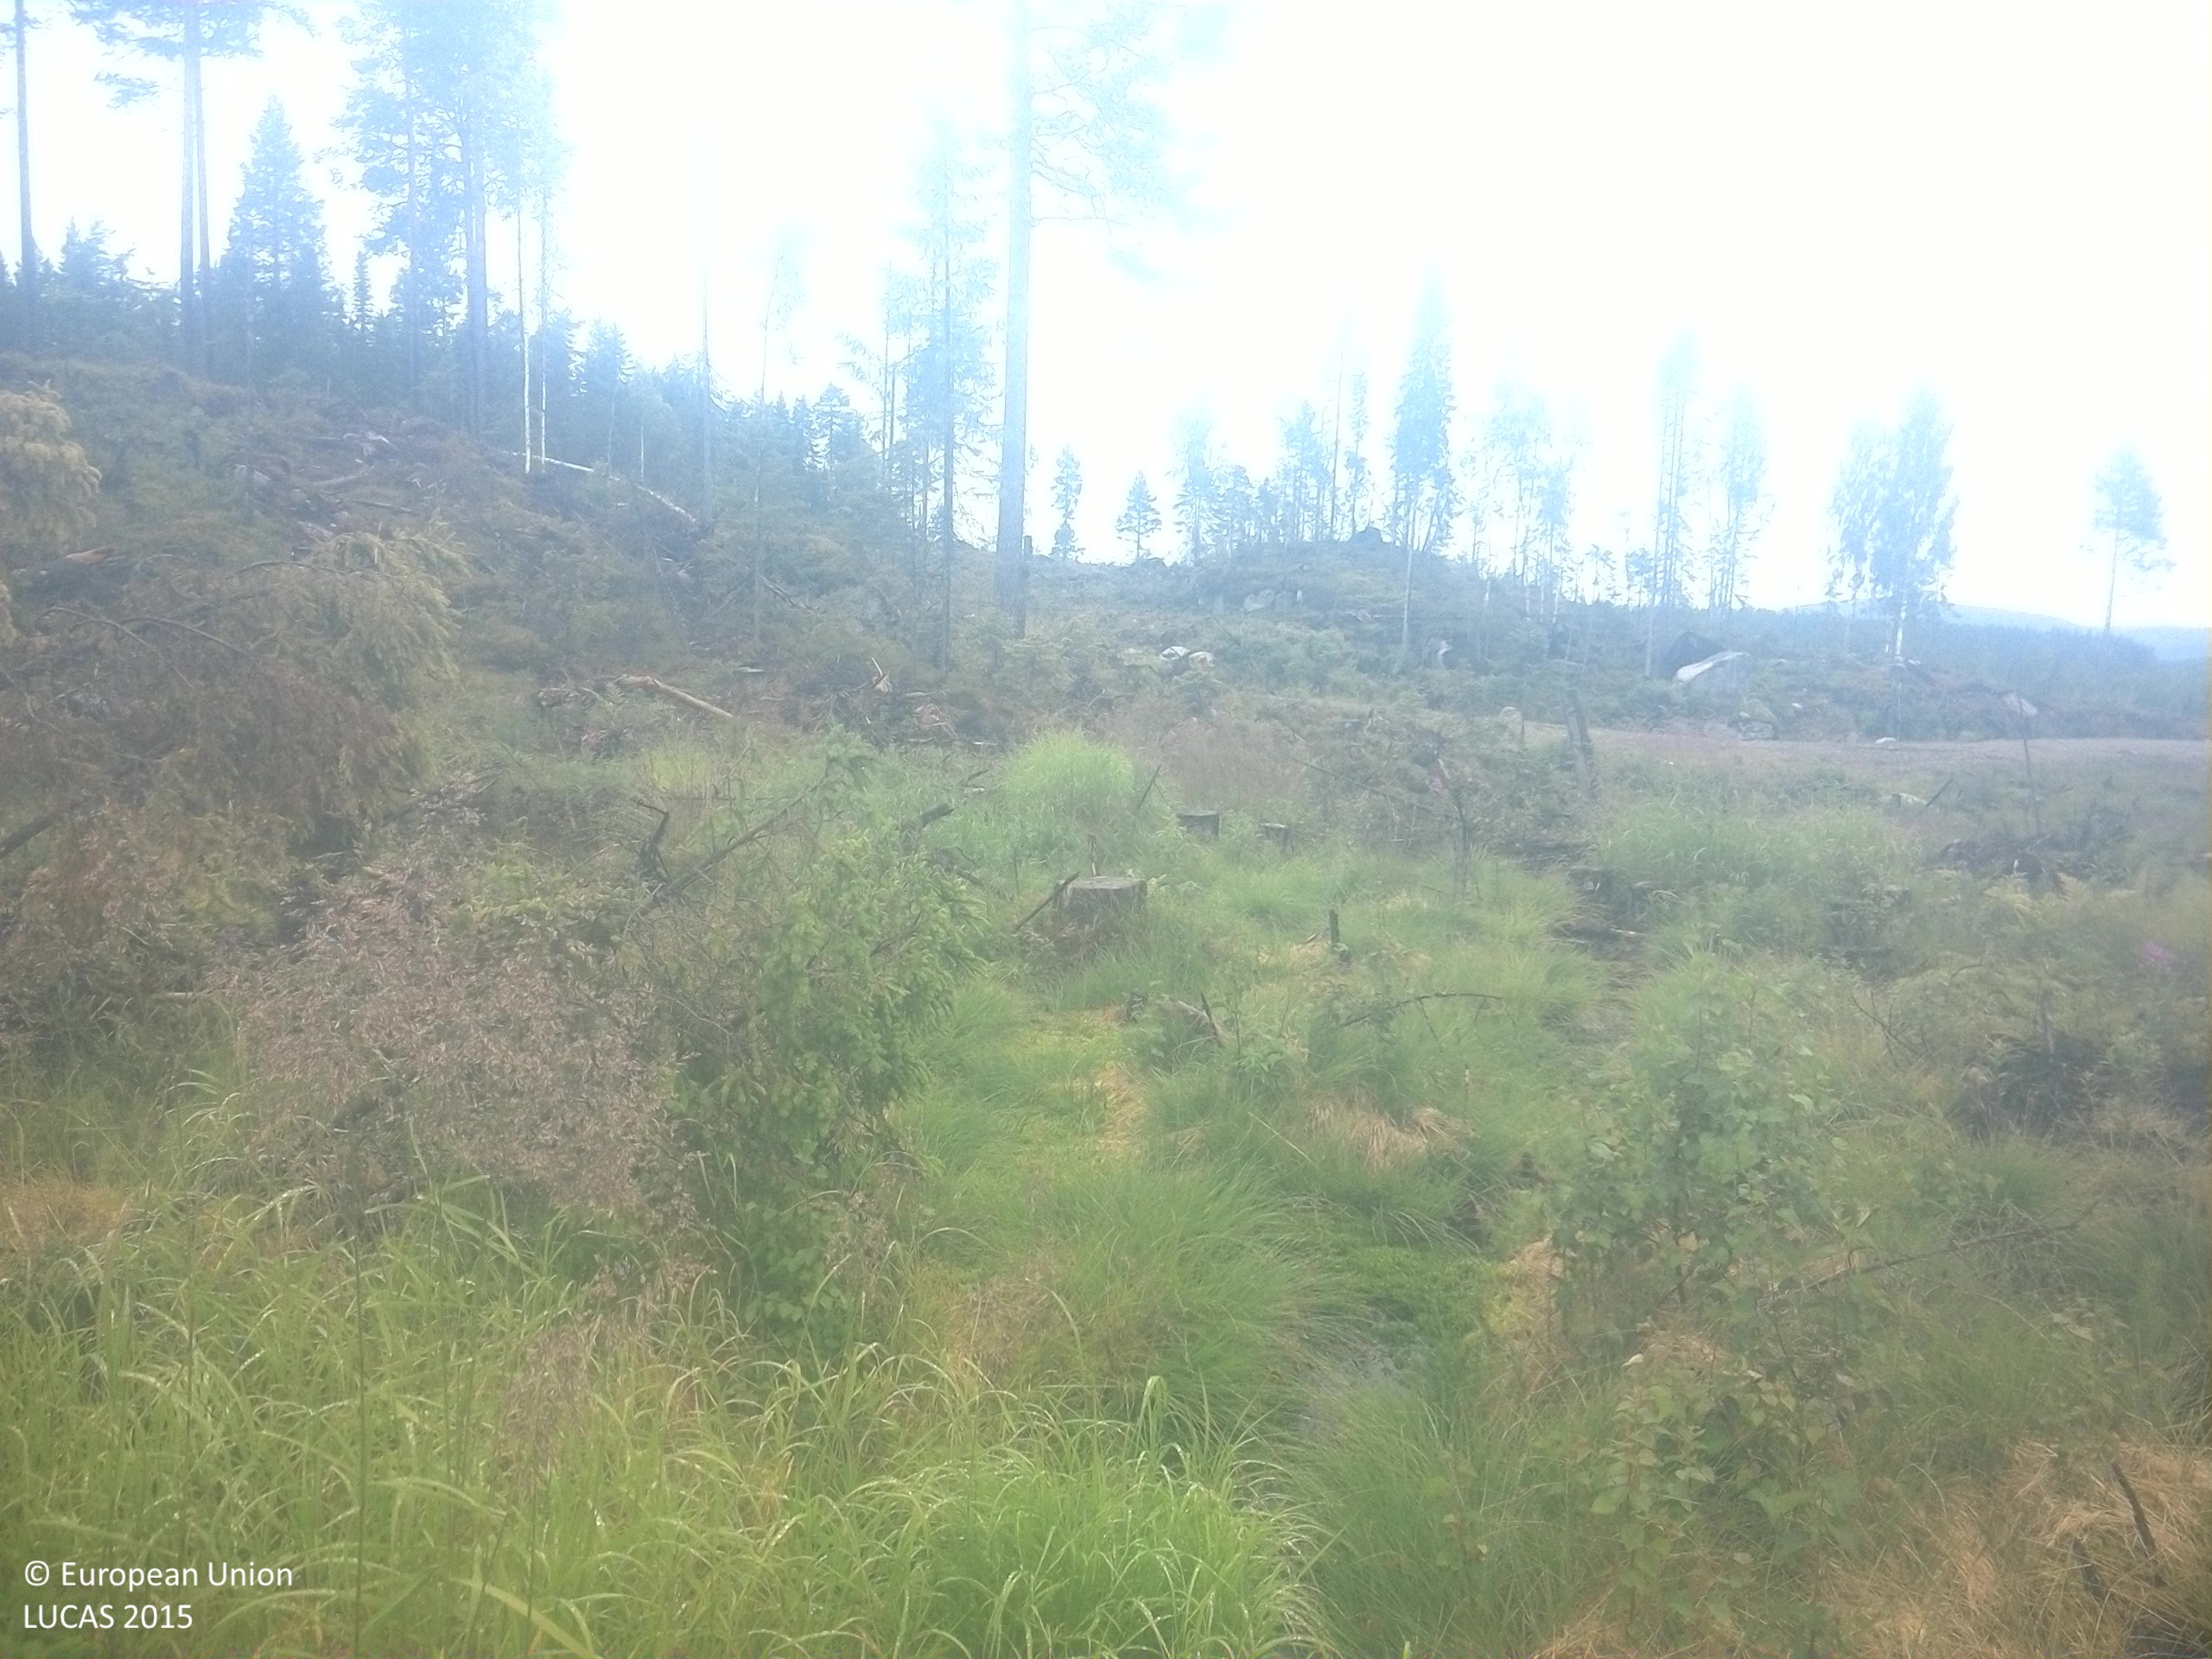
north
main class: Shrubland
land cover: Shrubland with sparse tree cover
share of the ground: 10 - 25 %
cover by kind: herbaceous plants 35 %, shrubs 20 %, lichens and mosses 15 %, unconsolidated bare surface 15 %, consolidated bare surface 10 %, coniferous forest trees 5 %
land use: Forestry
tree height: < 5 m
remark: Clear cut
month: August
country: SE
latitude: 63.5560
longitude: 16.5550
